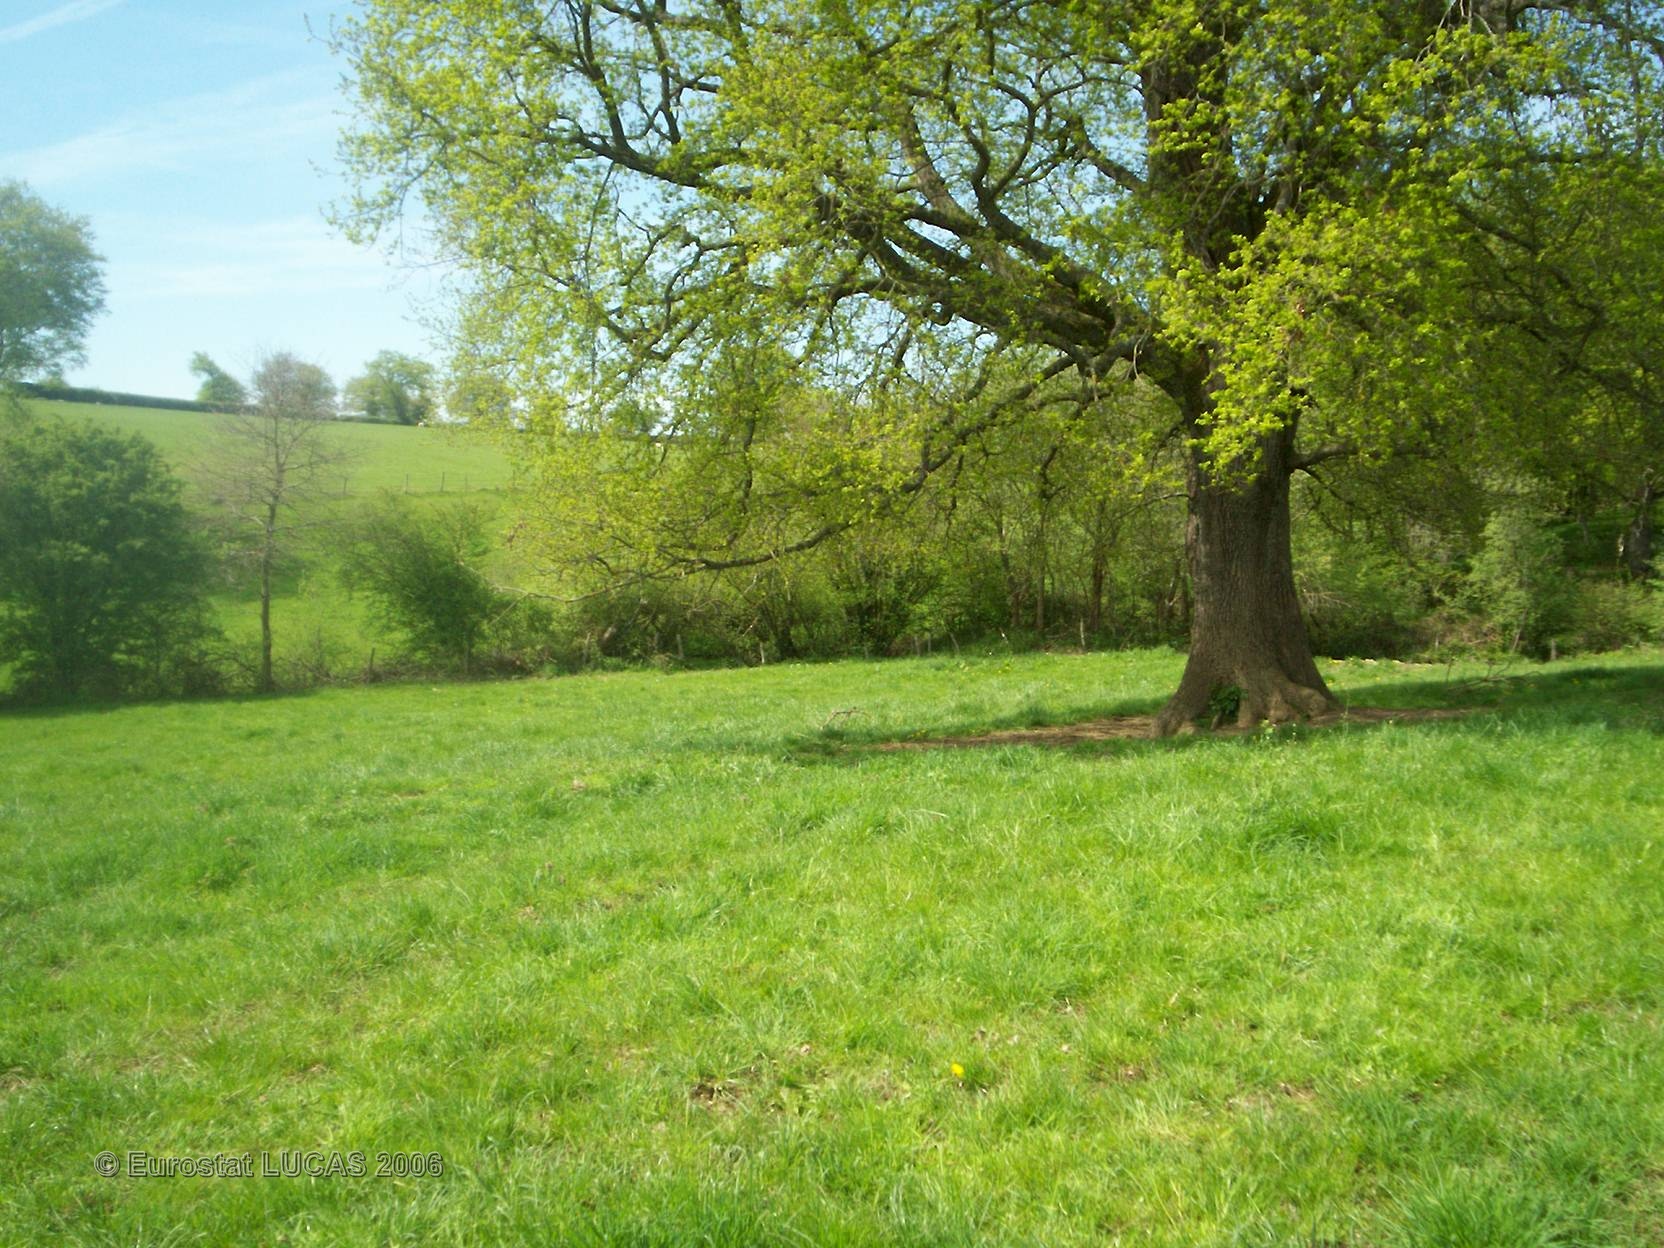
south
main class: Grassland
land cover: Grassland without tree/shrub cover
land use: Agriculture (excluding fallow land and kitchen gardens)
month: May
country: FR
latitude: 46.3826
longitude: 3.1197
